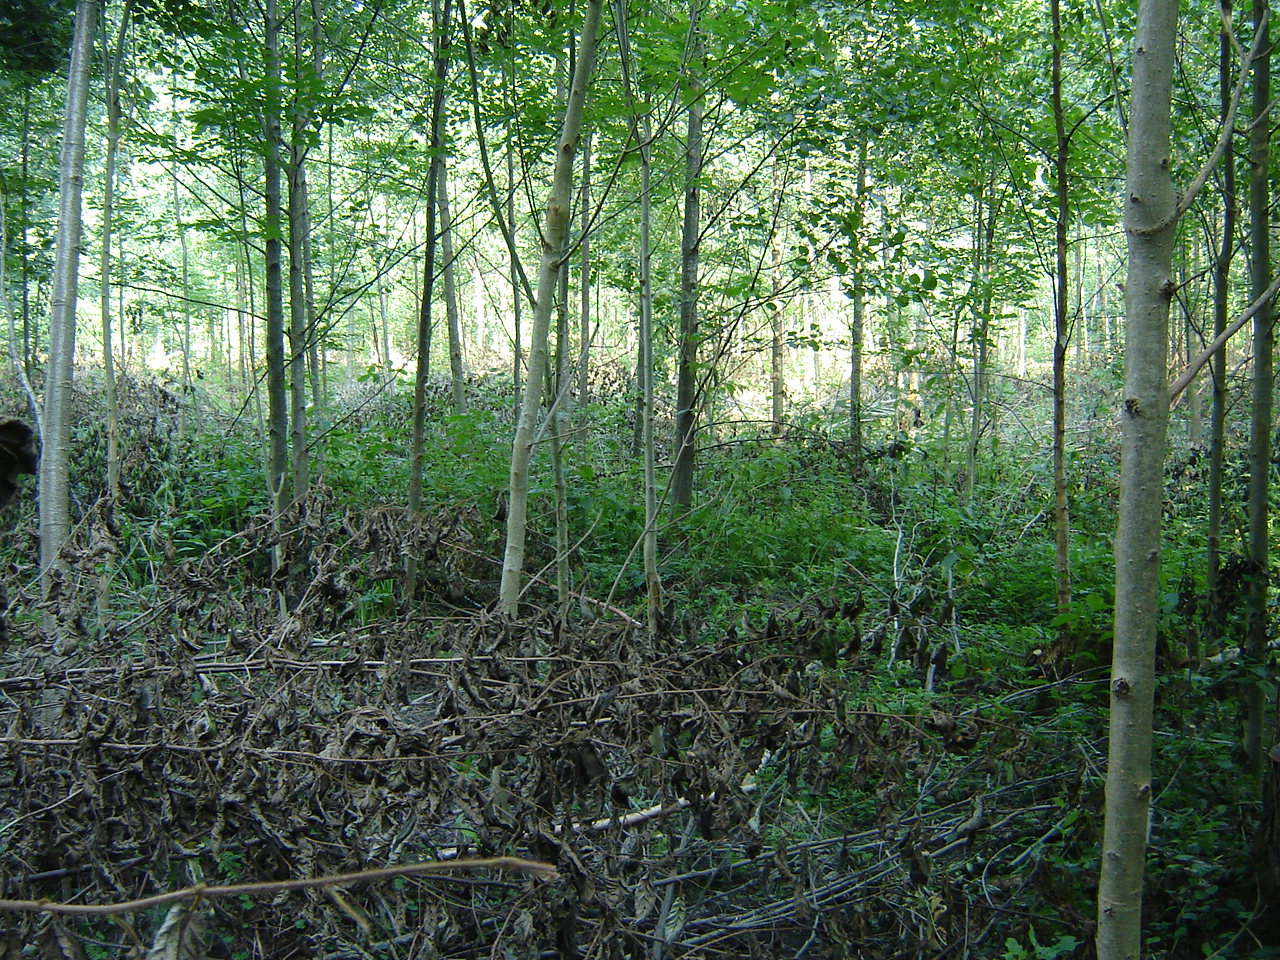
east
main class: Woodland
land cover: Broadleaved woodland
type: non-riverine alder, birch or aspen forest
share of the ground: > 75 %
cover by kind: broadleaved forest trees 80 %, unconsolidated bare surface 10 %, coniferous forest trees 5 %, herbaceous plants 5 %
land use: Forestry
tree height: > 5 m
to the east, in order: Broadleaved woodland; Spruce dominated mixed woodland
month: August
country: LT
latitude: 55.1064
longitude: 24.9237
